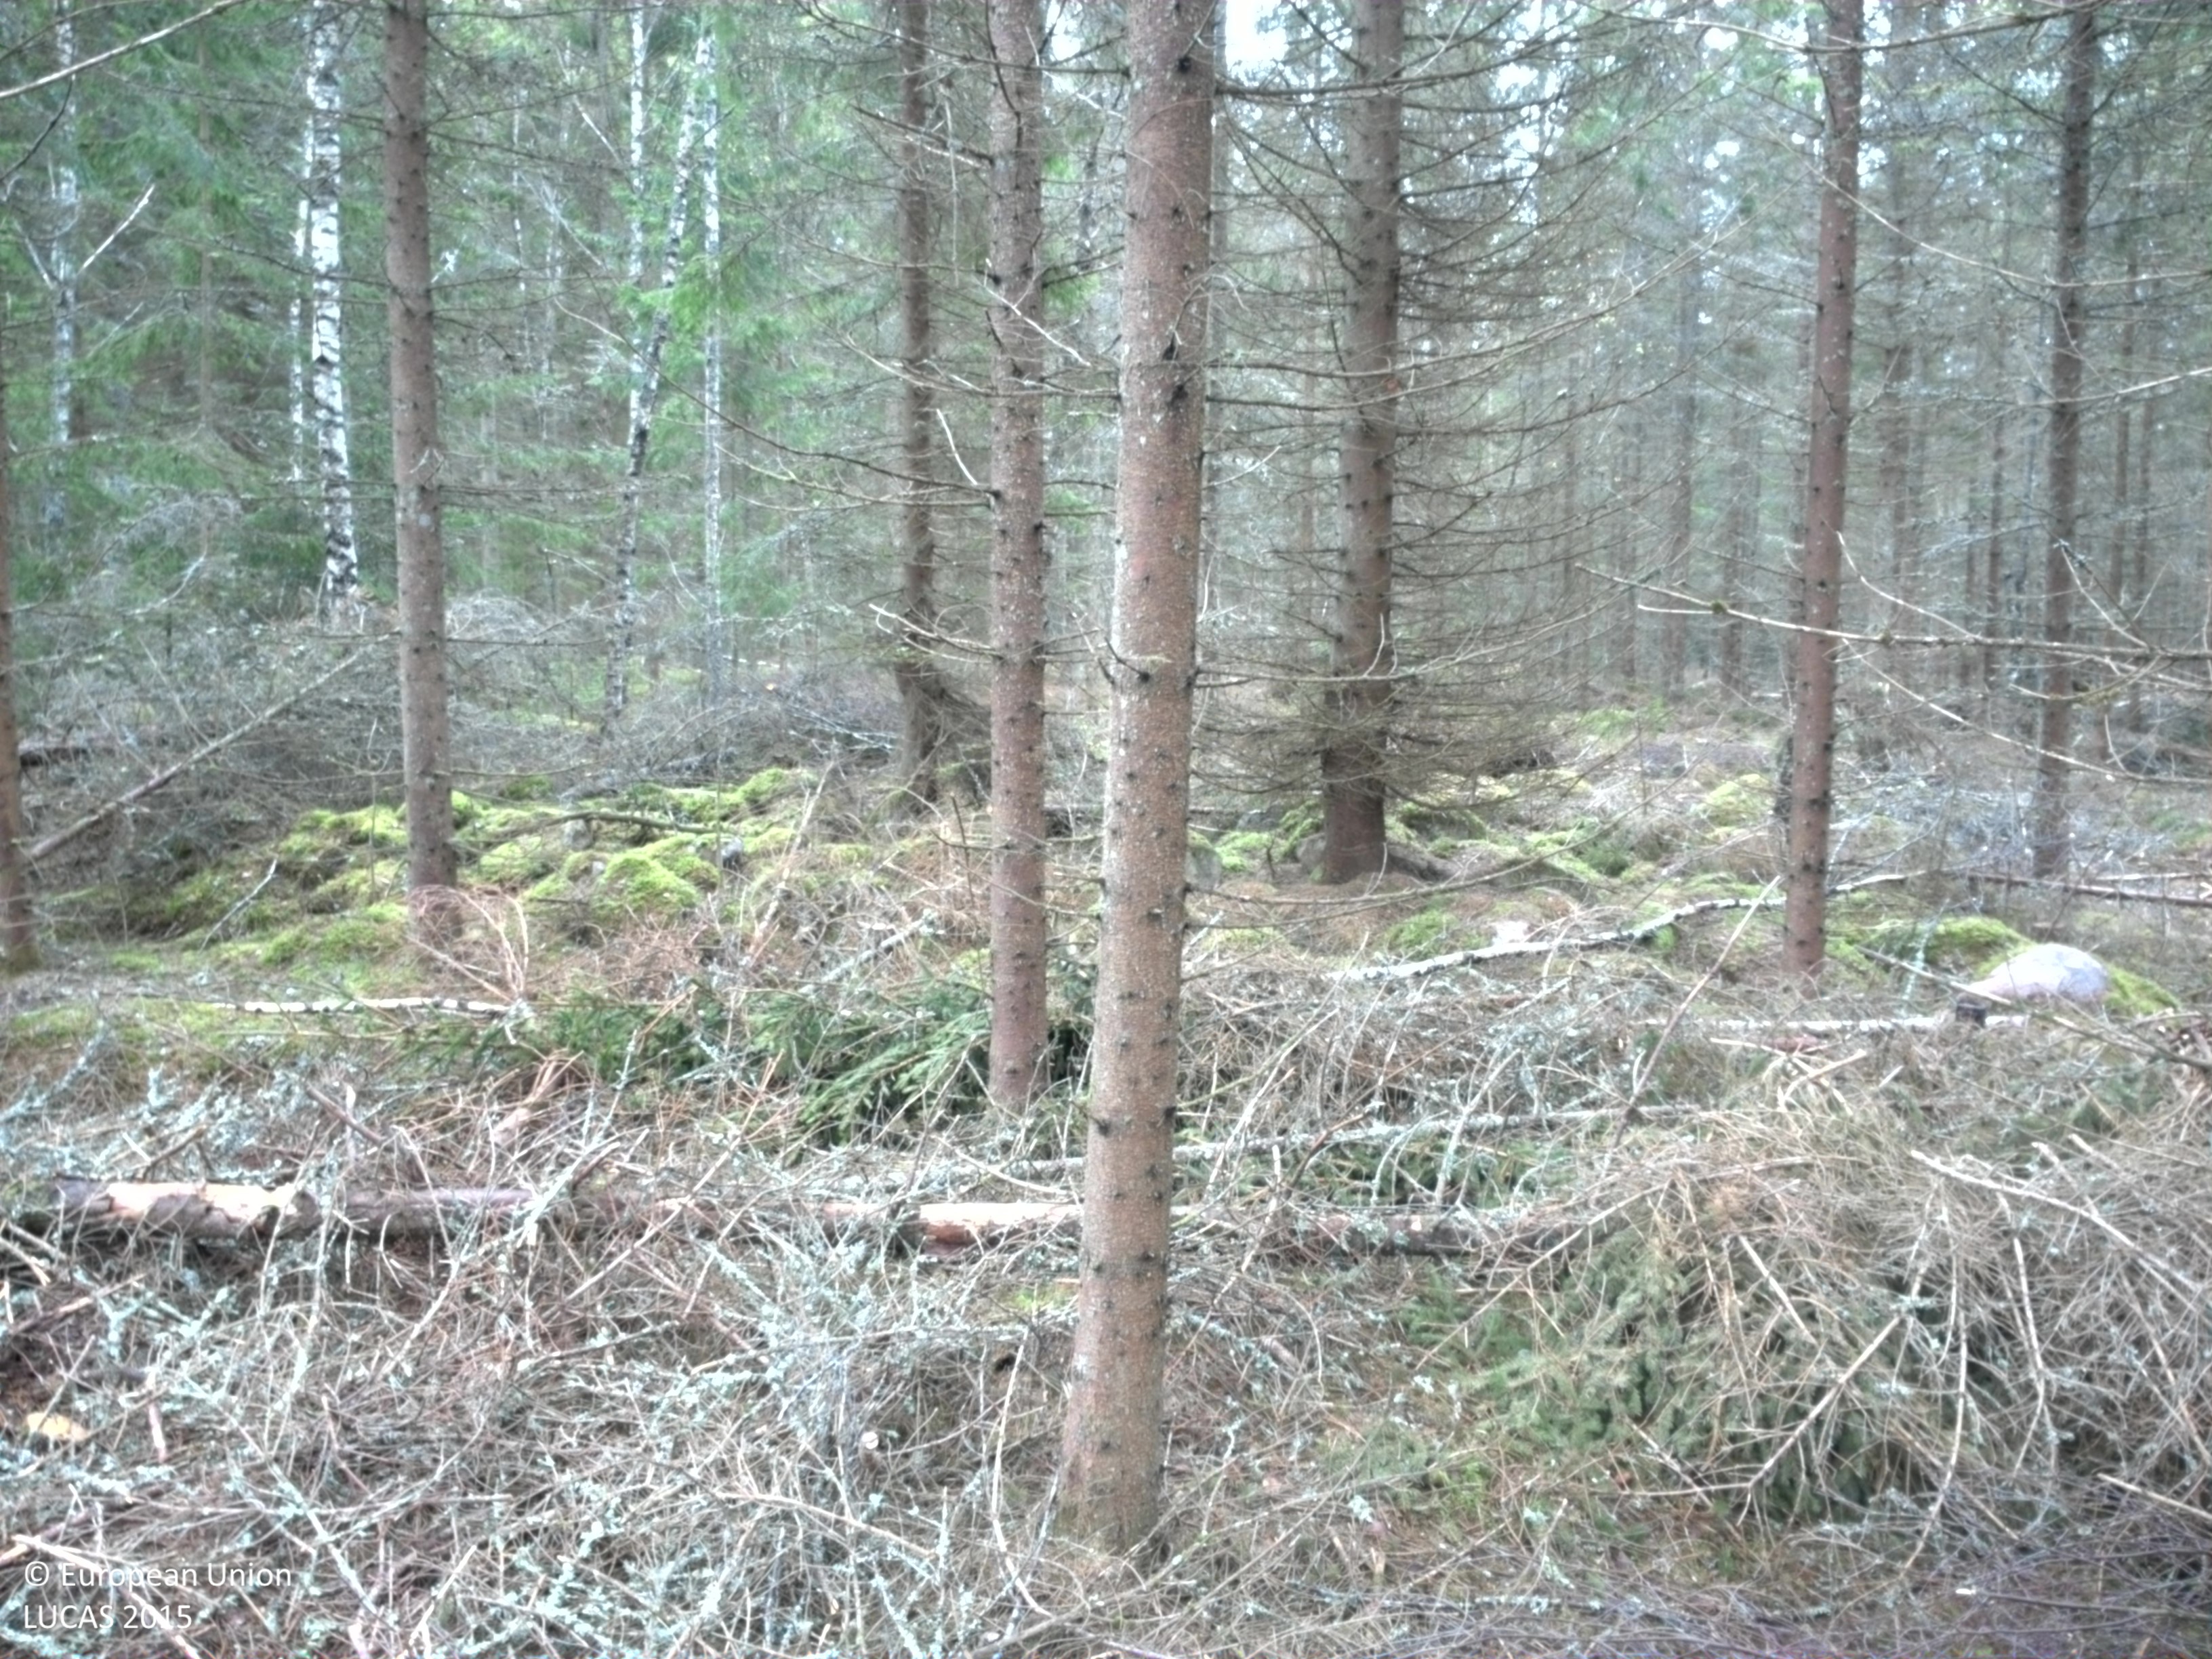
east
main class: Woodland
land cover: Spruce dominated coniferous woodland
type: boreal forest
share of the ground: > 75 %
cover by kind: coniferous forest trees 70 %, lichens and mosses 20 %, broadleaved forest trees 10 %
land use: Forestry
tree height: > 5 m
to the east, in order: Spruce dominated coniferous woodland; Rivers and streams; Spruce dominated coniferous woodland
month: May
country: SE
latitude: 56.6103
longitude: 15.0650
